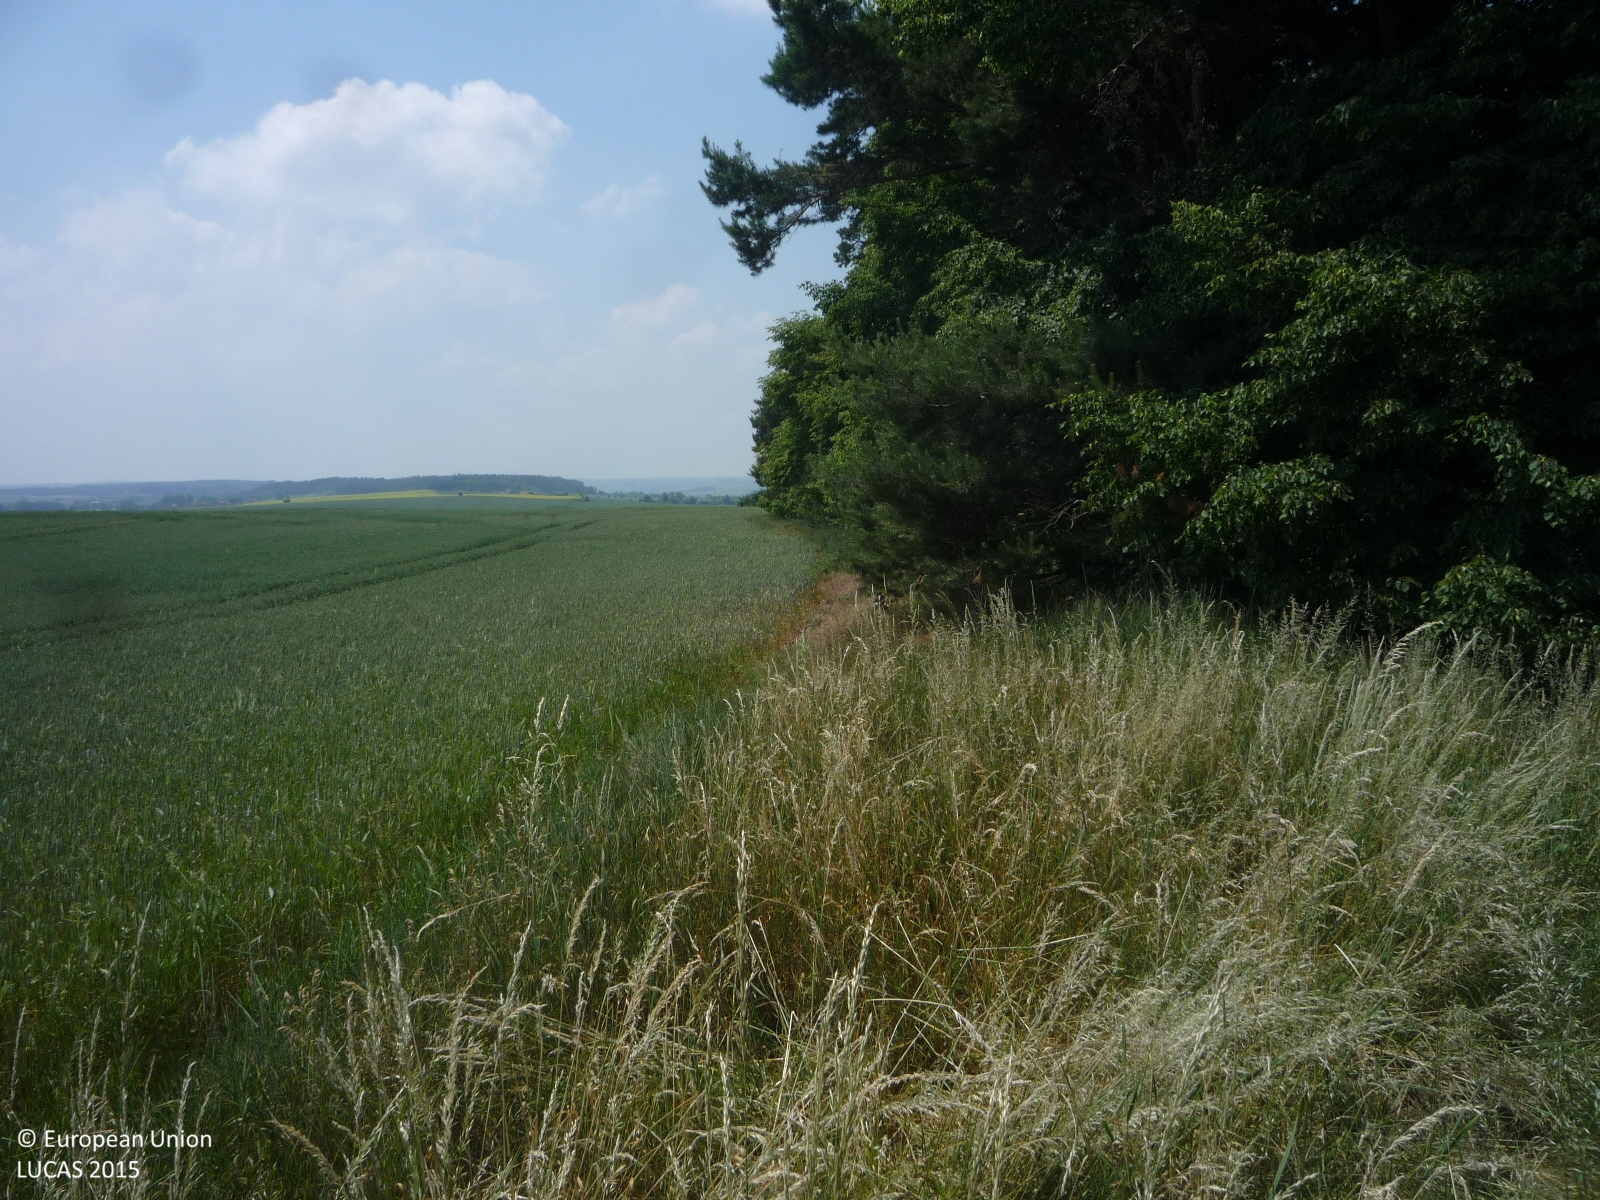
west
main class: Grassland
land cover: Grassland with sparse tree/shrub cover
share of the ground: > 75 %
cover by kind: herbaceous plants 90 %, broadleaved forest trees 5 %, shrubs 5 %
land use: Semi-natural and natural areas not in use
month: June
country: CZ
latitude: 50.2562
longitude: 14.0545
